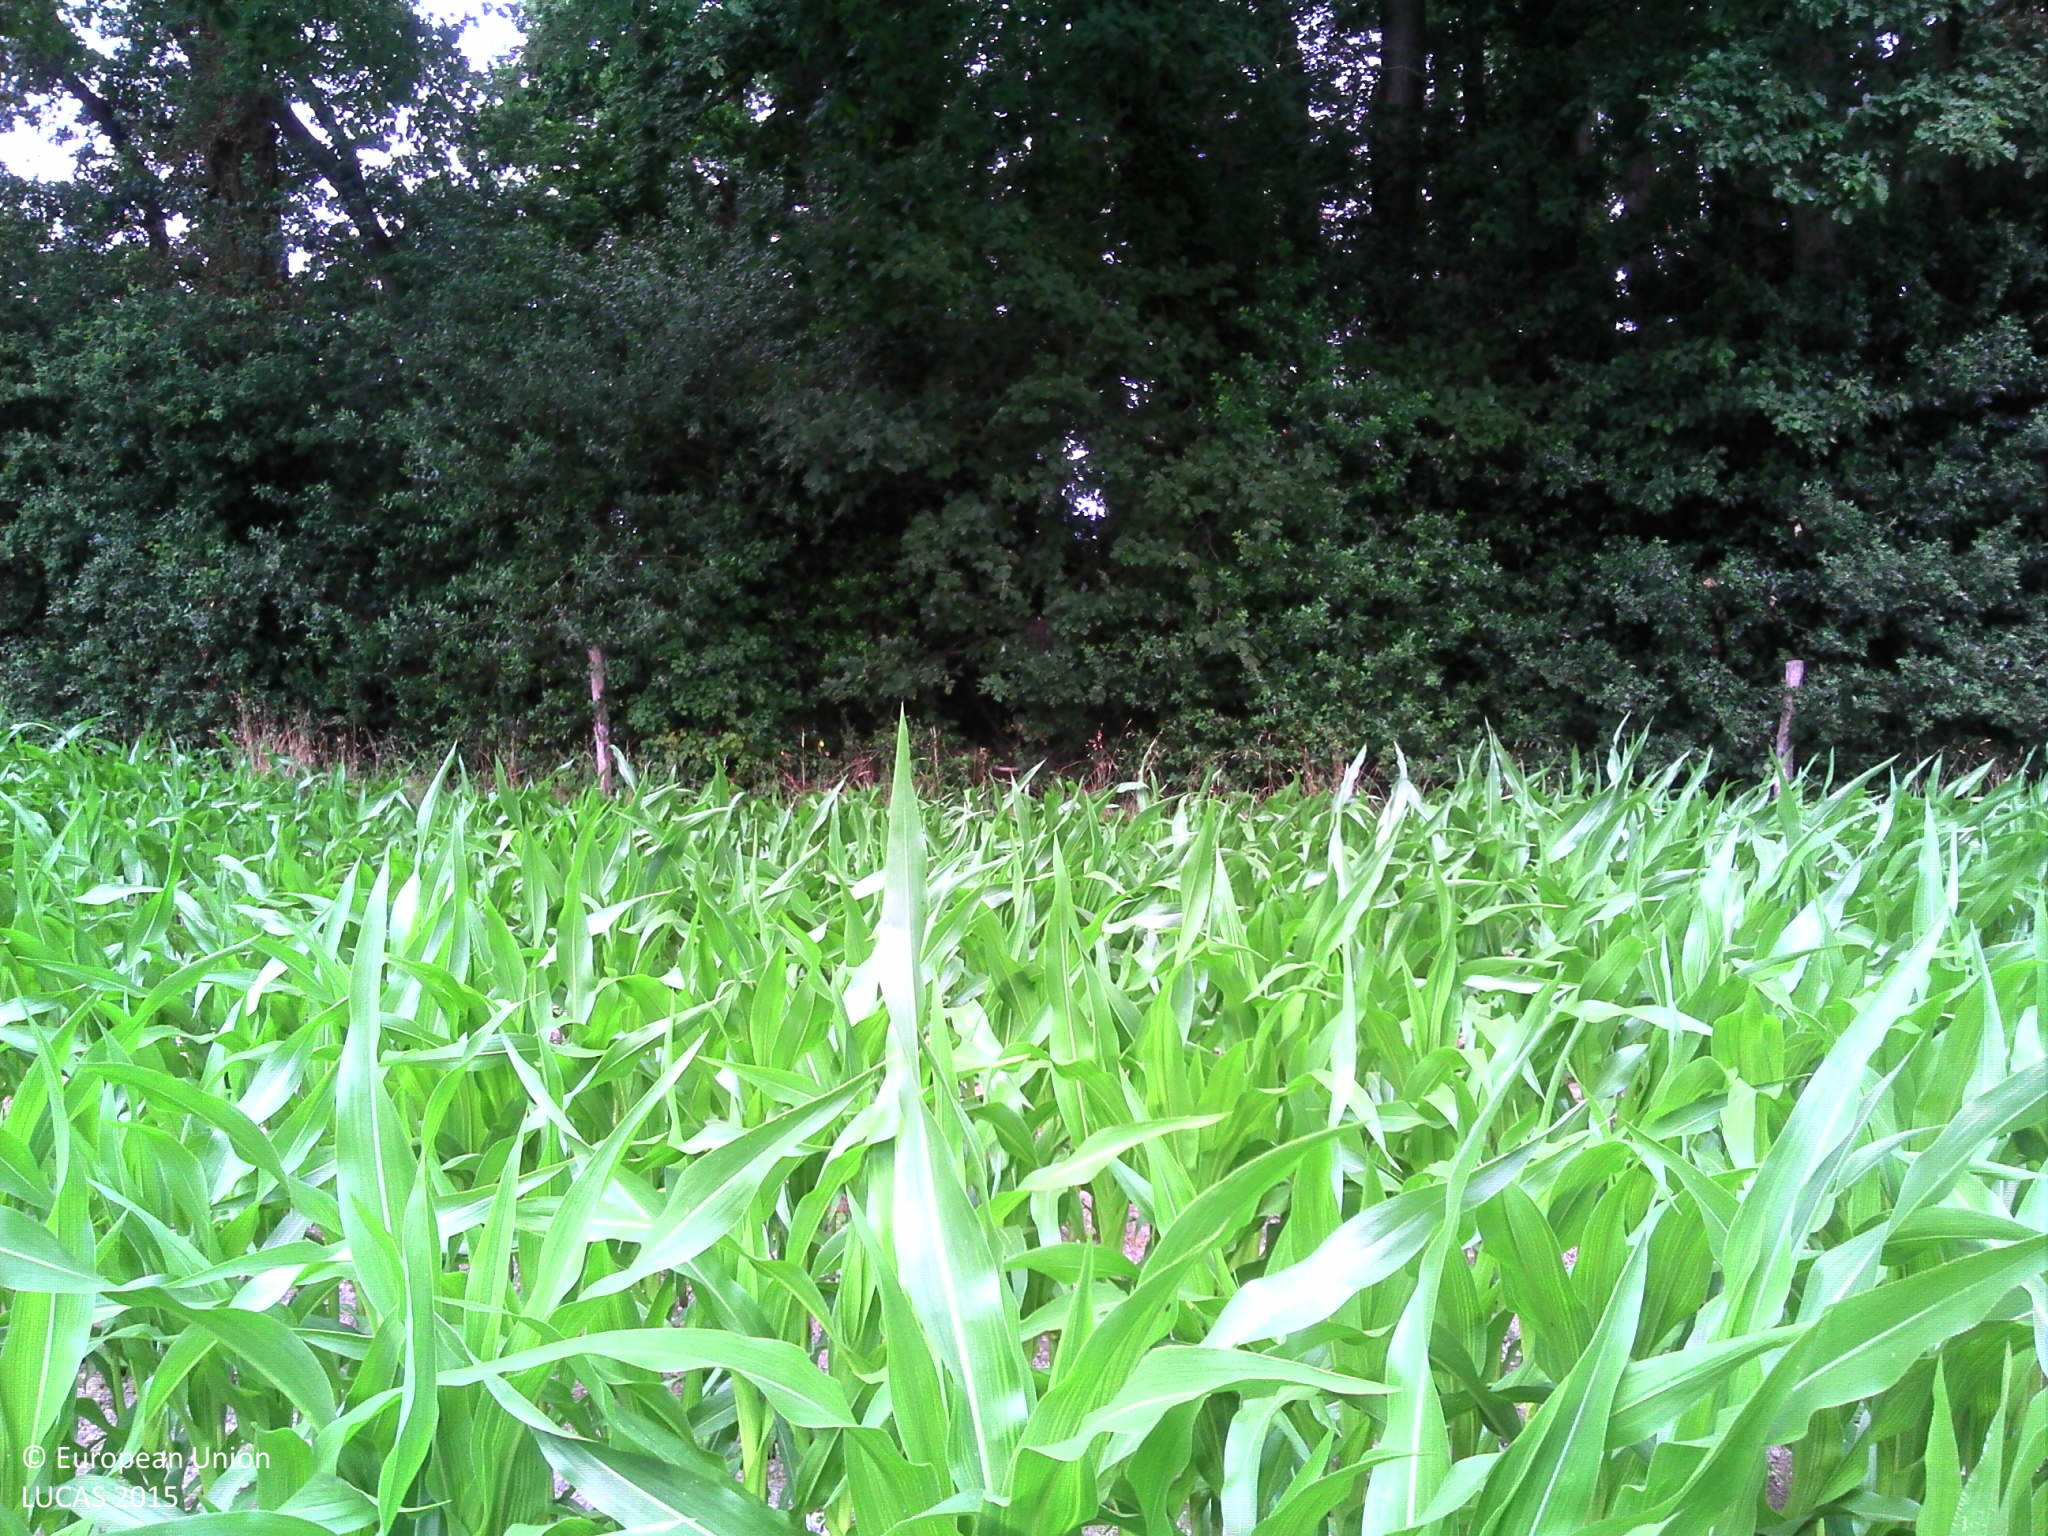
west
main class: Cropland
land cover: Maize
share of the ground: > 75 %
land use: Agriculture (excluding fallow land and kitchen gardens)
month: July
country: FR
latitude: 47.5799
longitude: -1.8677
